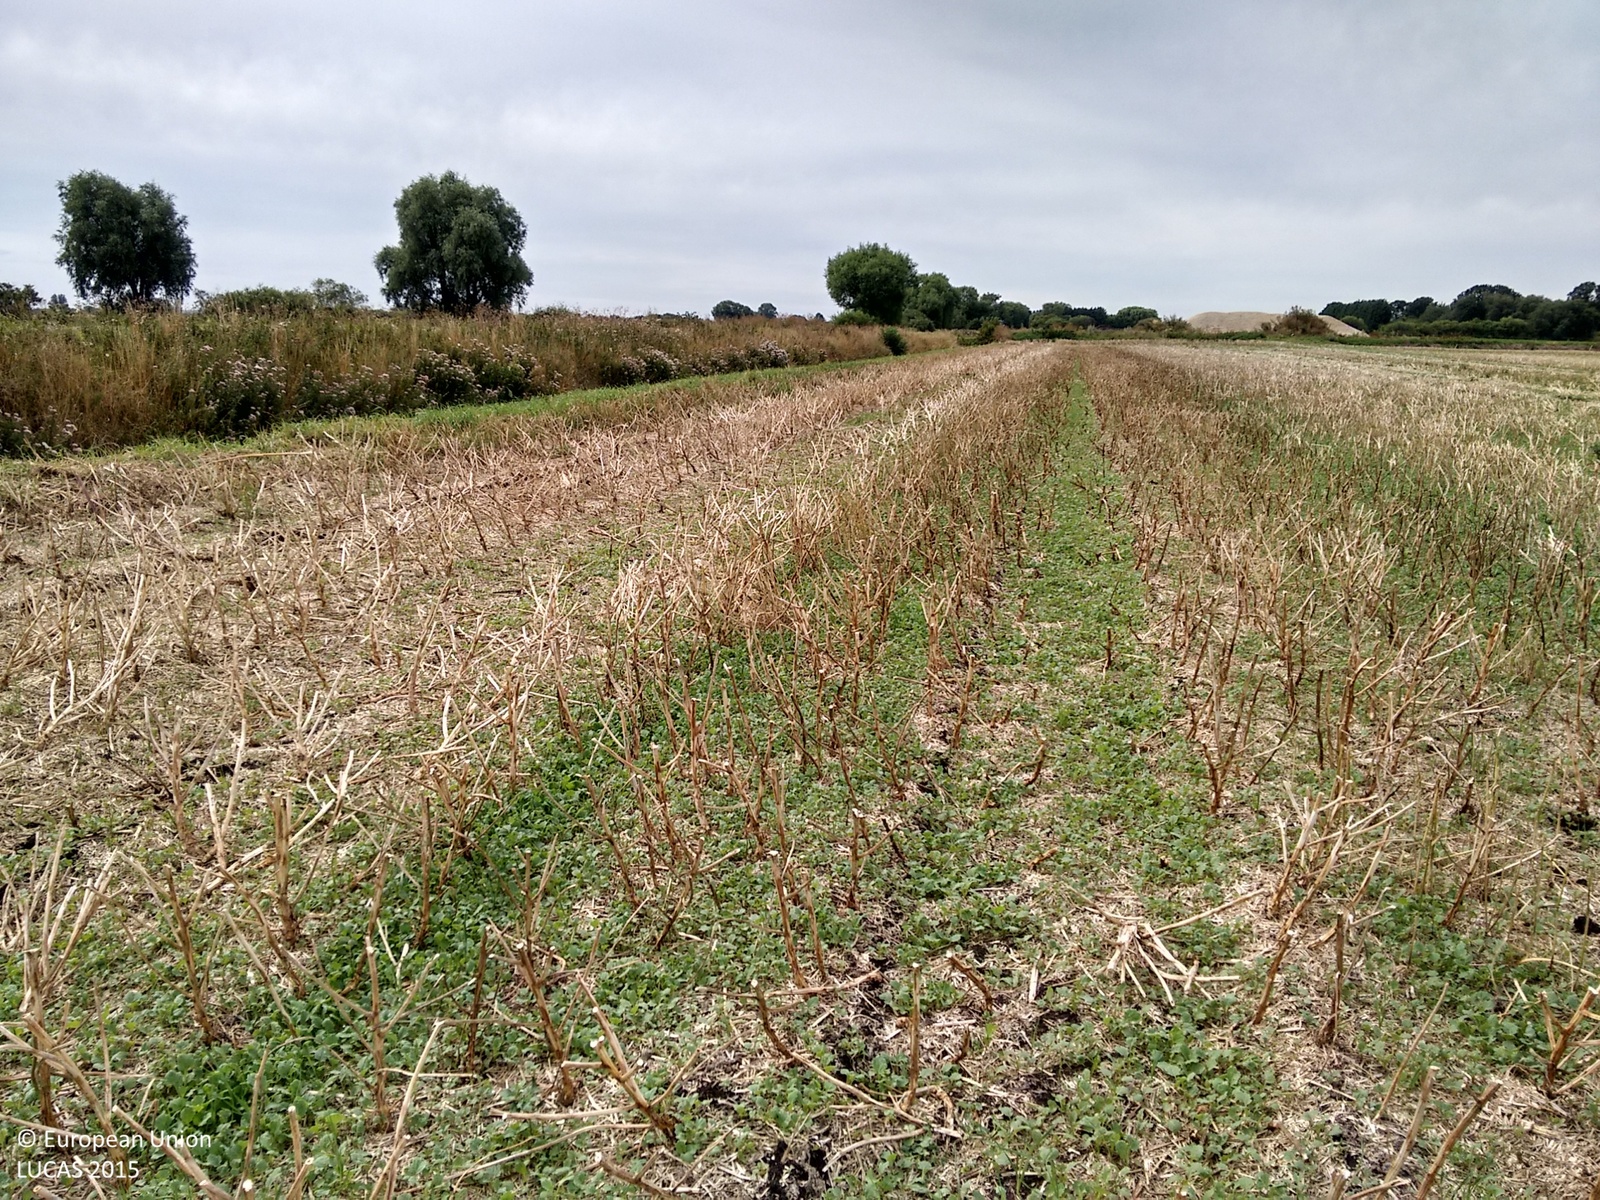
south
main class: Cropland
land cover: Rape and turnip rape
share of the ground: > 75 %
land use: Agriculture (excluding fallow land and kitchen gardens)
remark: Harvested field
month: August
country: GB
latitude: 52.5336
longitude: 0.4338
